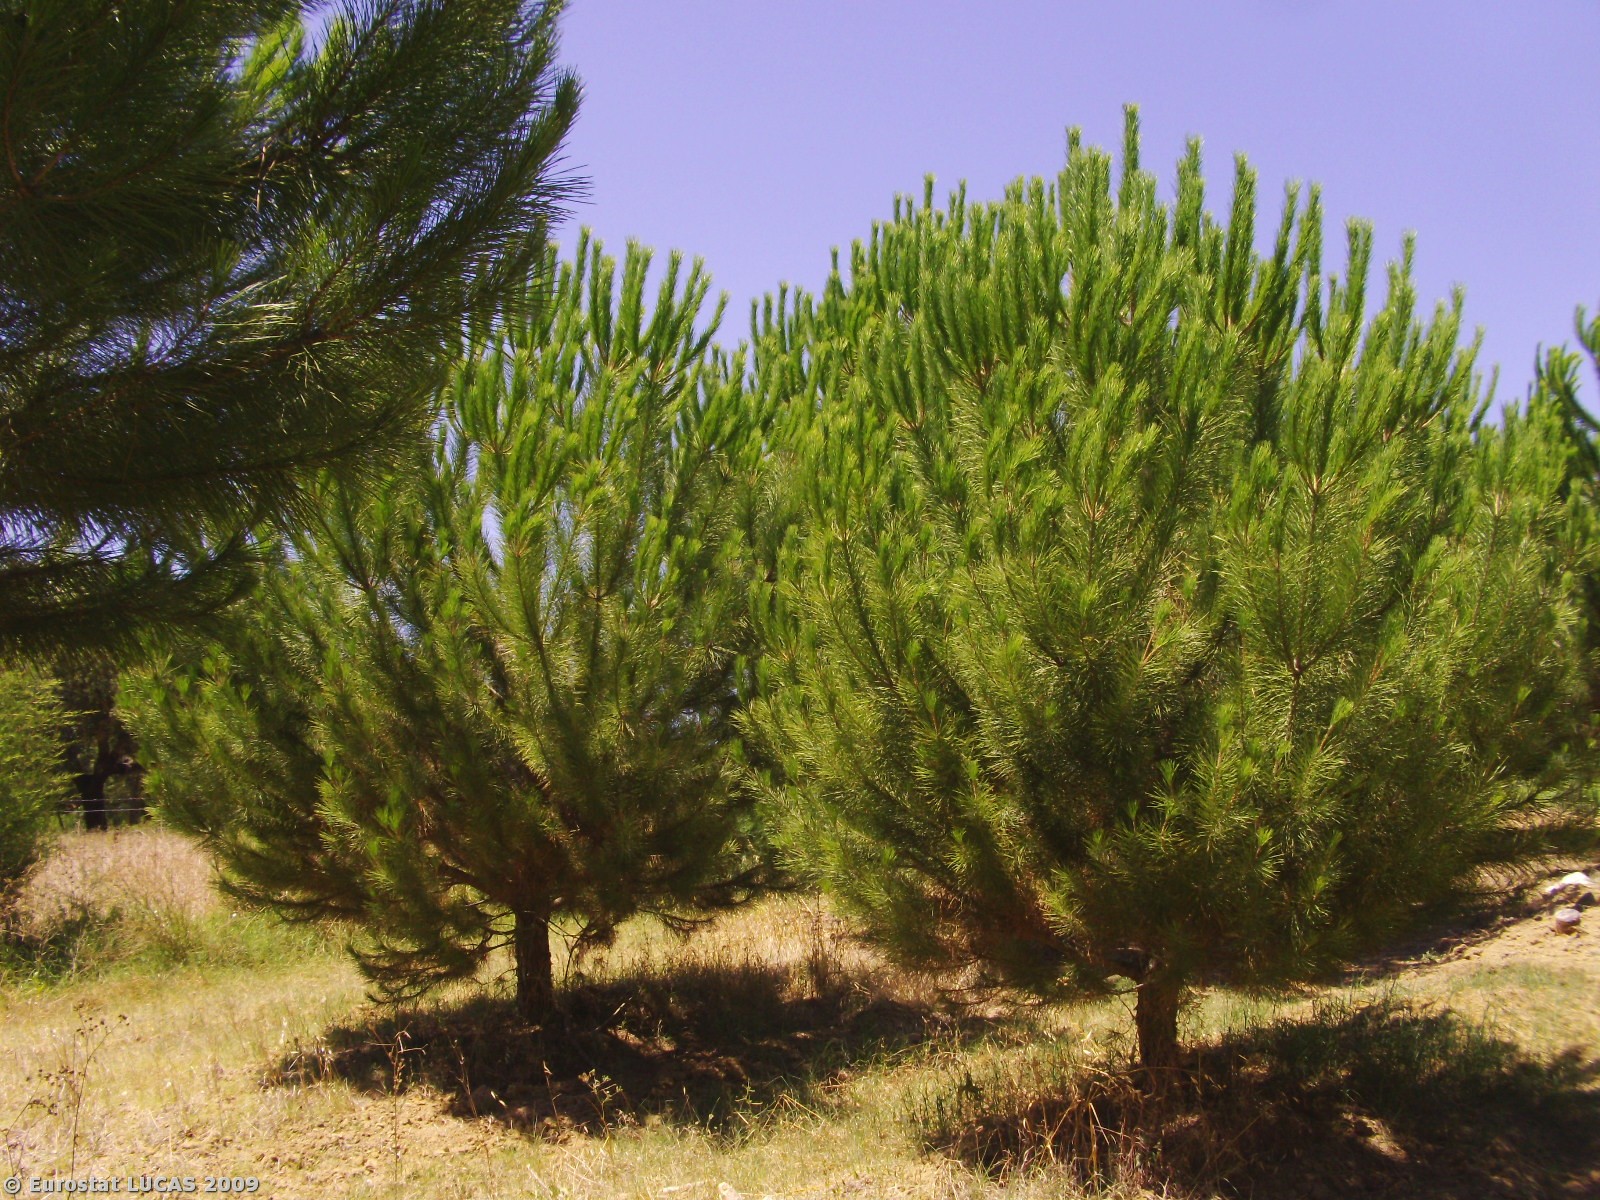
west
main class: Woodland
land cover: Coniferous woodland
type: coniferous forest of the mediterranean region
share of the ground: 10 - 25 %
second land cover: Bare land
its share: 50 - 75 %
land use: Forestry
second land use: Fallow land
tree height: > 5 m
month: July
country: PT
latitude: 39.1343
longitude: -8.8035
